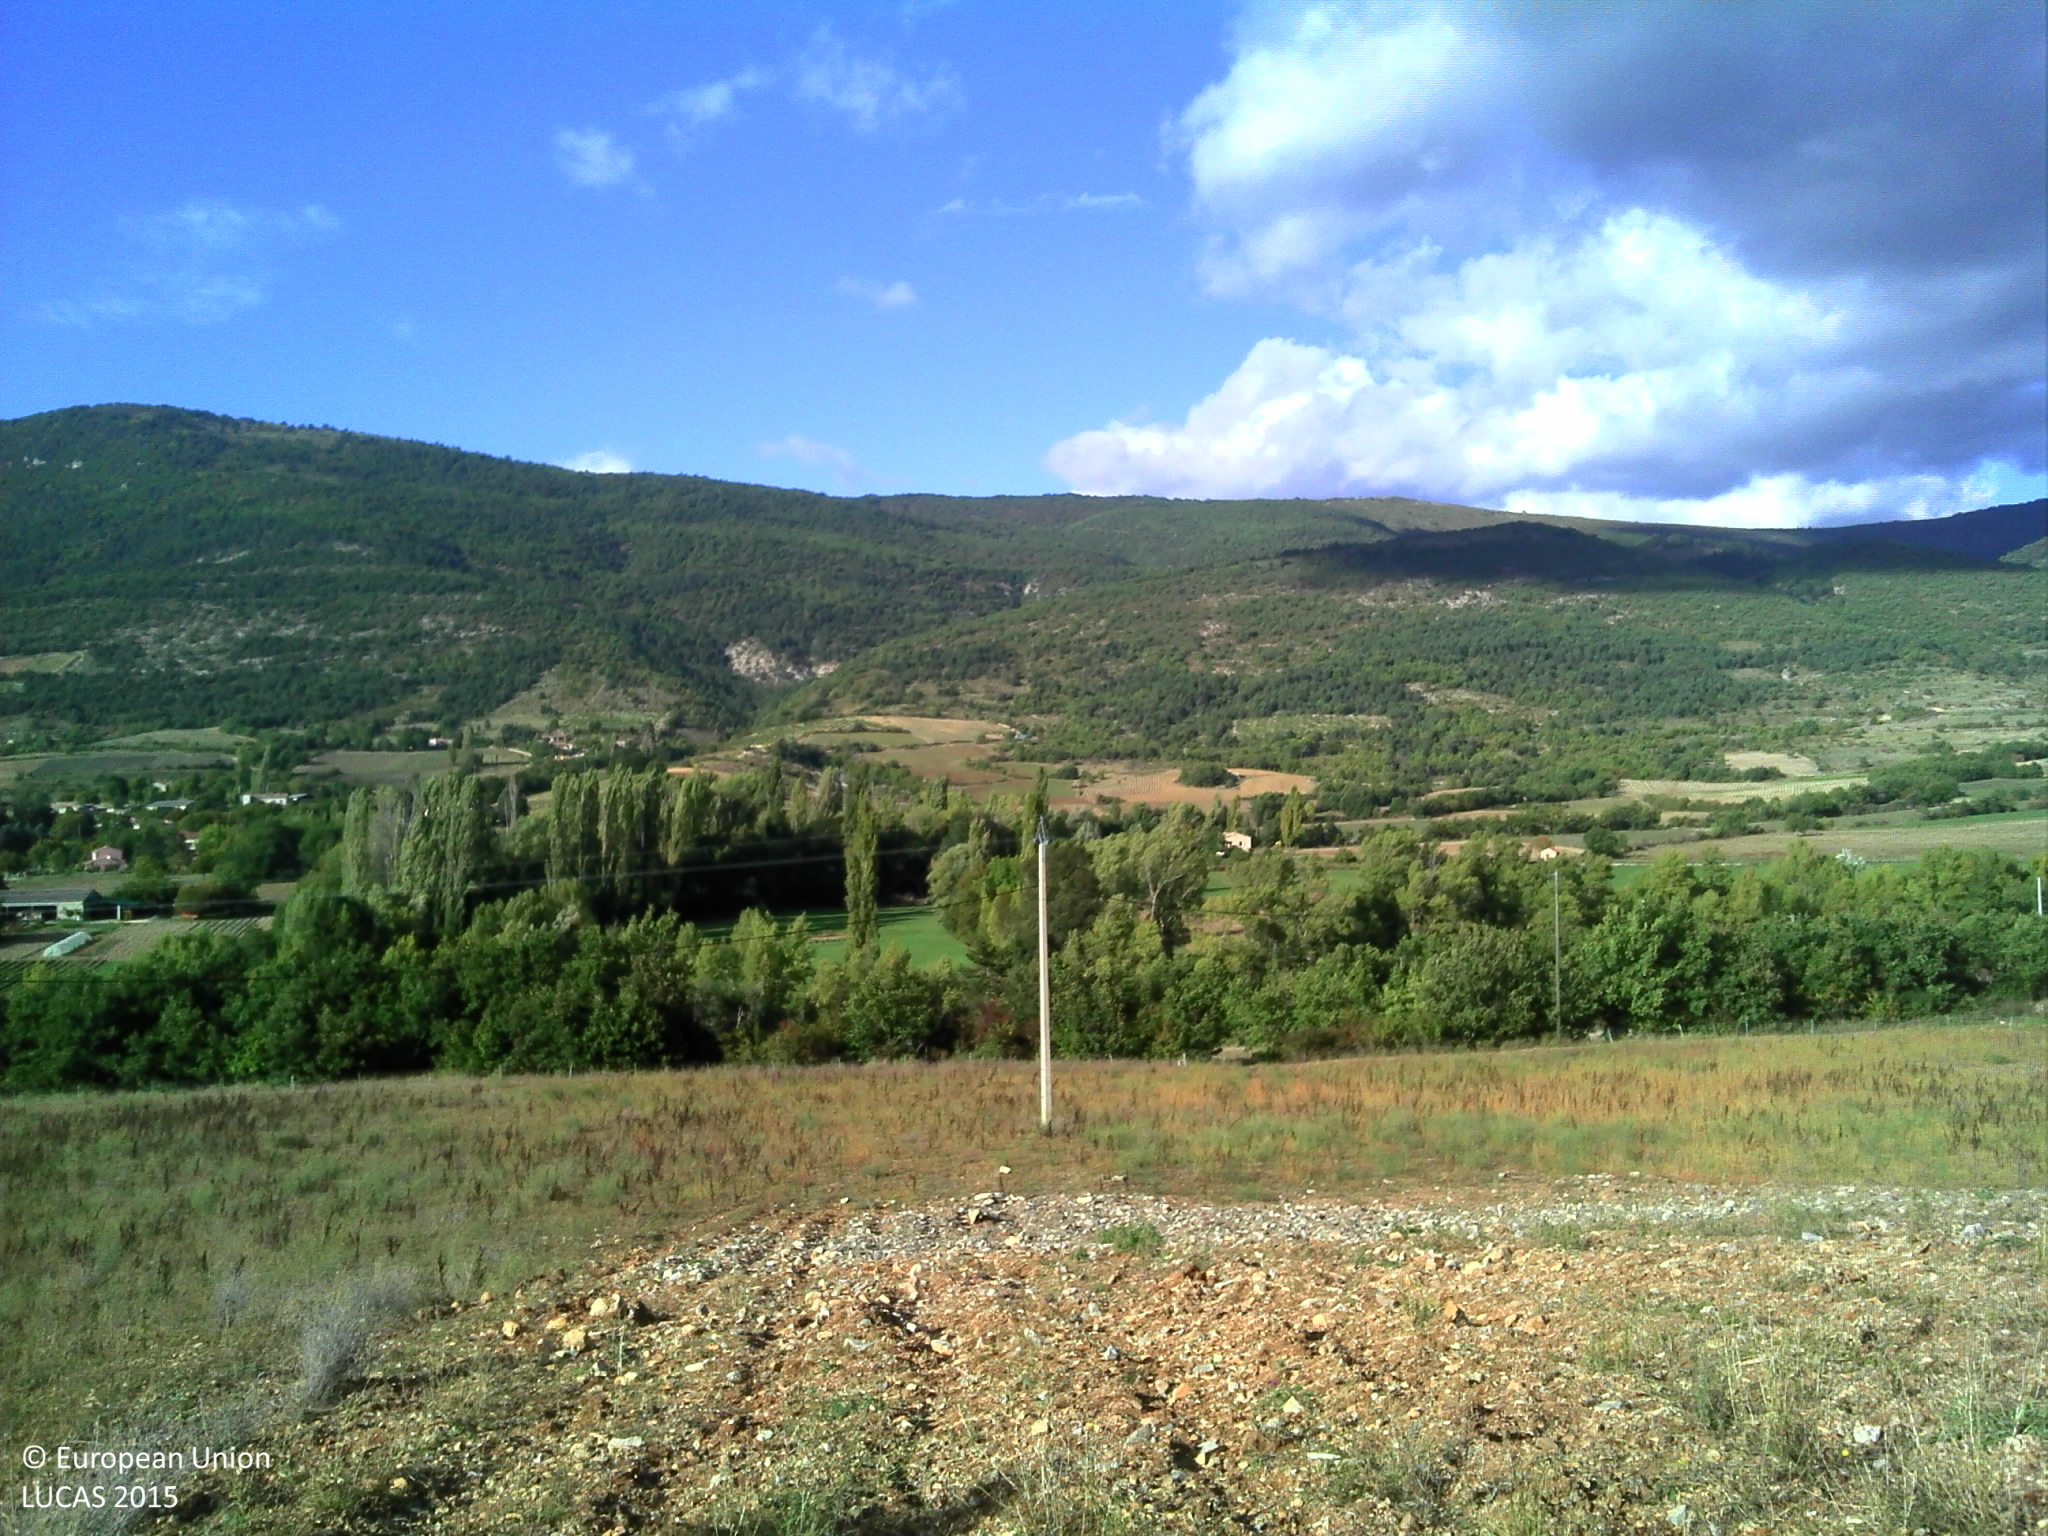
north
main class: Grassland
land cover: Grassland without tree/shrub cover
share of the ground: 50 - 75 %
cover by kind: herbaceous plants 60 %, unconsolidated bare surface 40 %
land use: Agriculture (excluding fallow land and kitchen gardens)
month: September
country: FR
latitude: 44.2862
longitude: 5.4337
